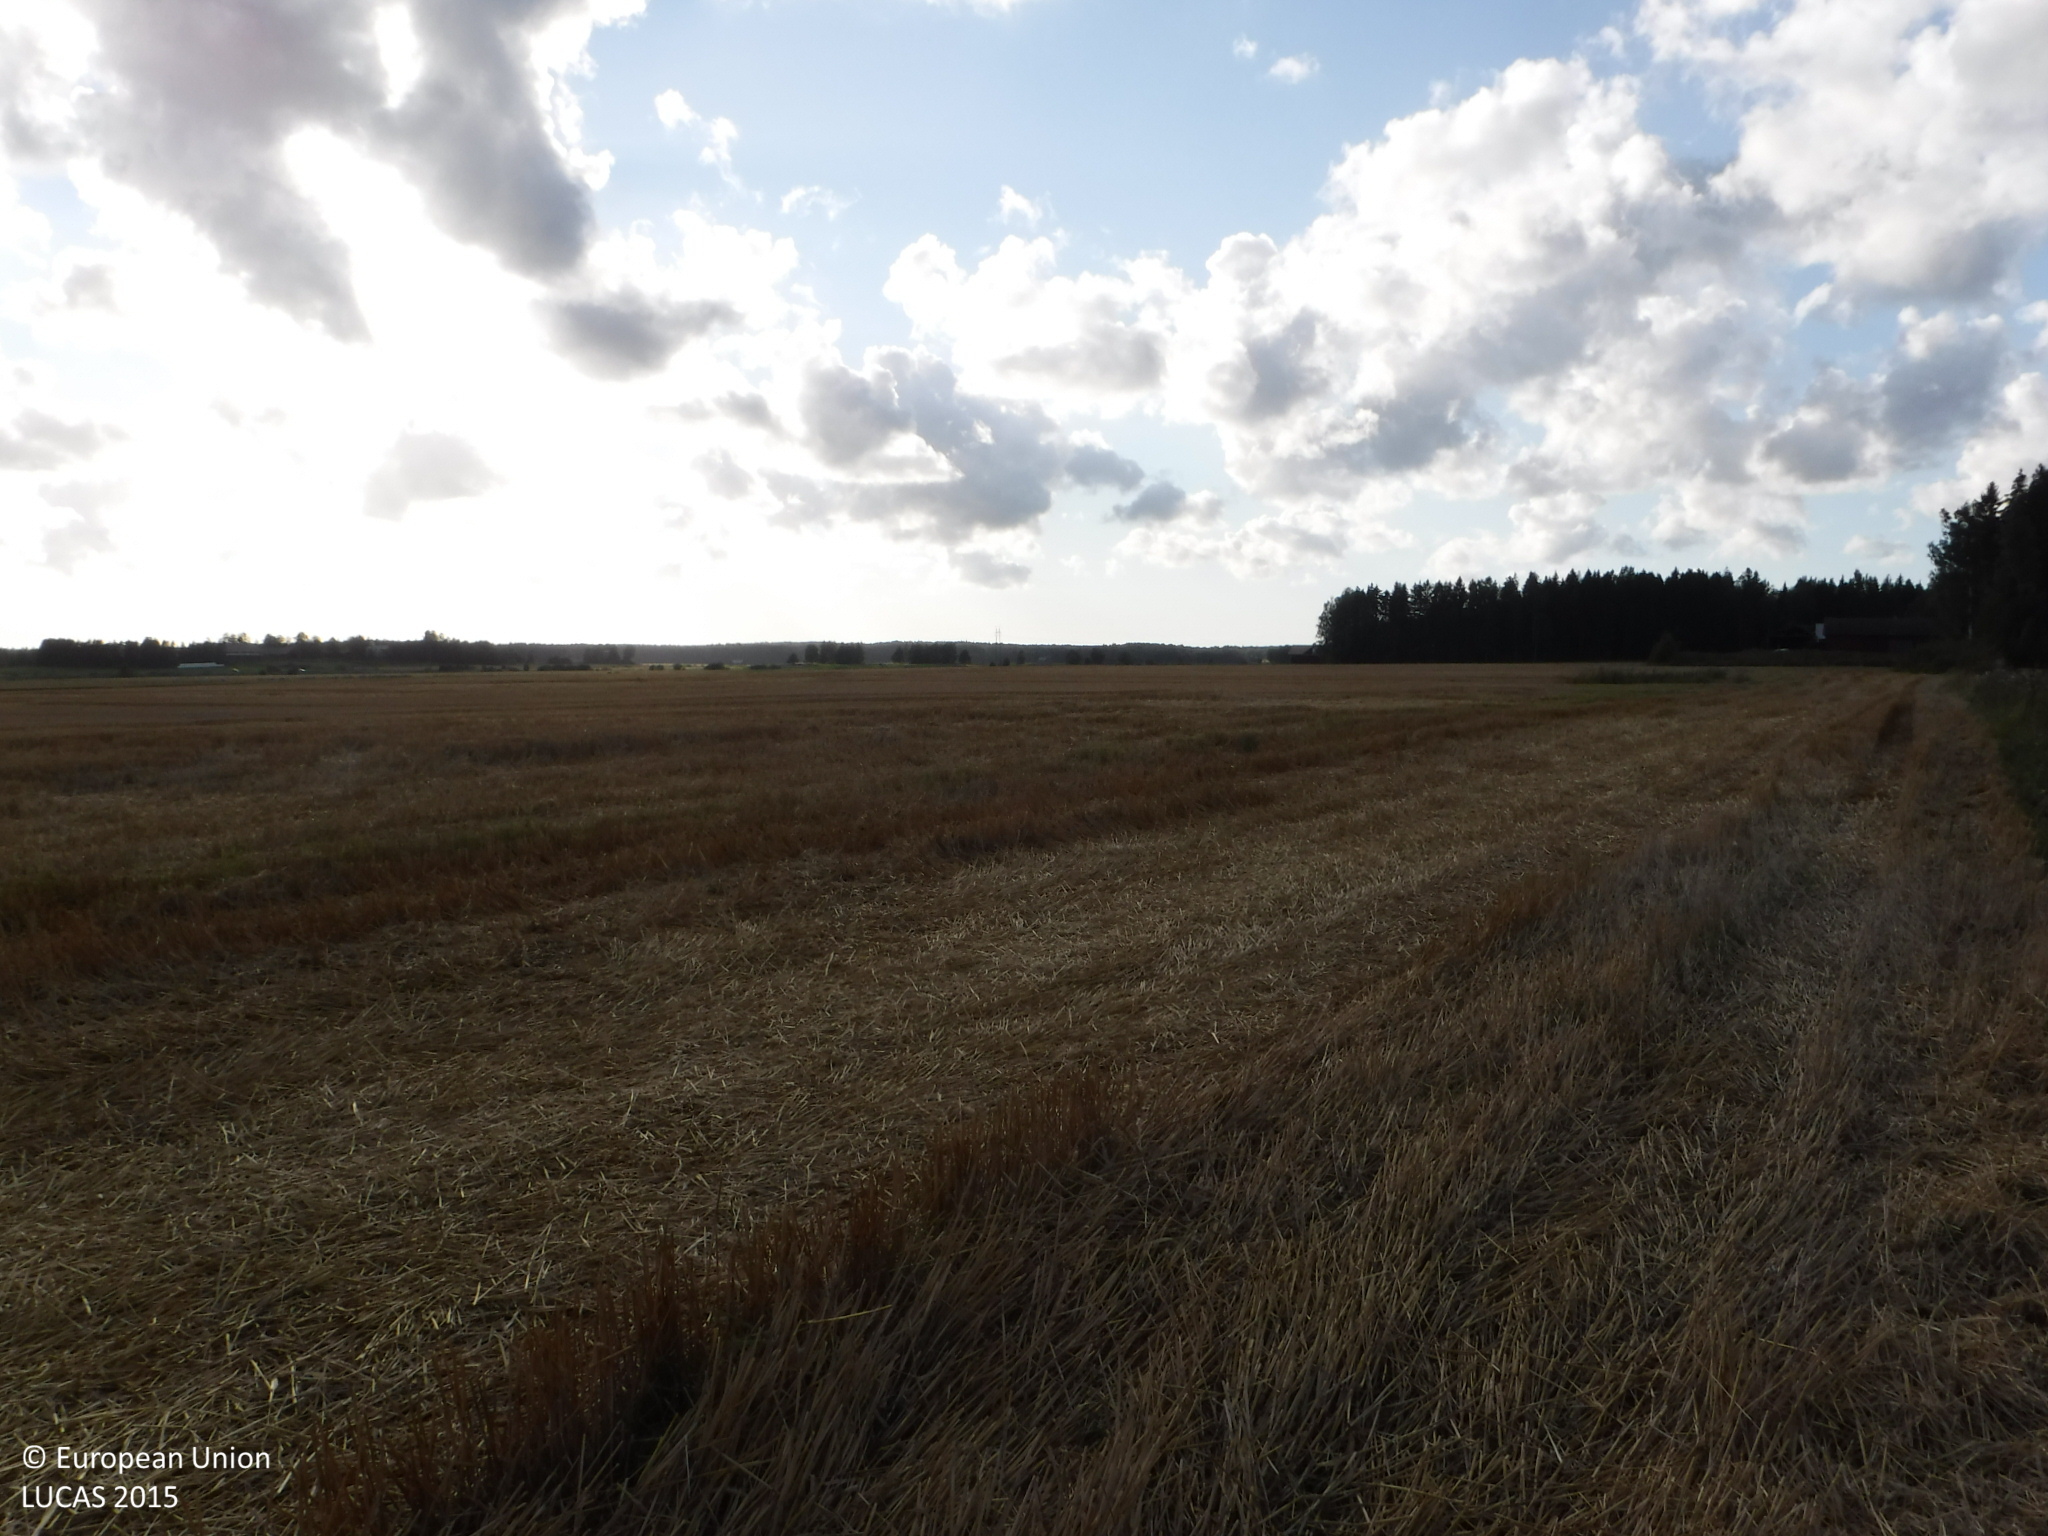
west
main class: Cropland
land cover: Rye
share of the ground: > 75 %
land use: Agriculture (excluding fallow land and kitchen gardens)
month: August
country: FI
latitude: 61.2471
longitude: 22.0794
